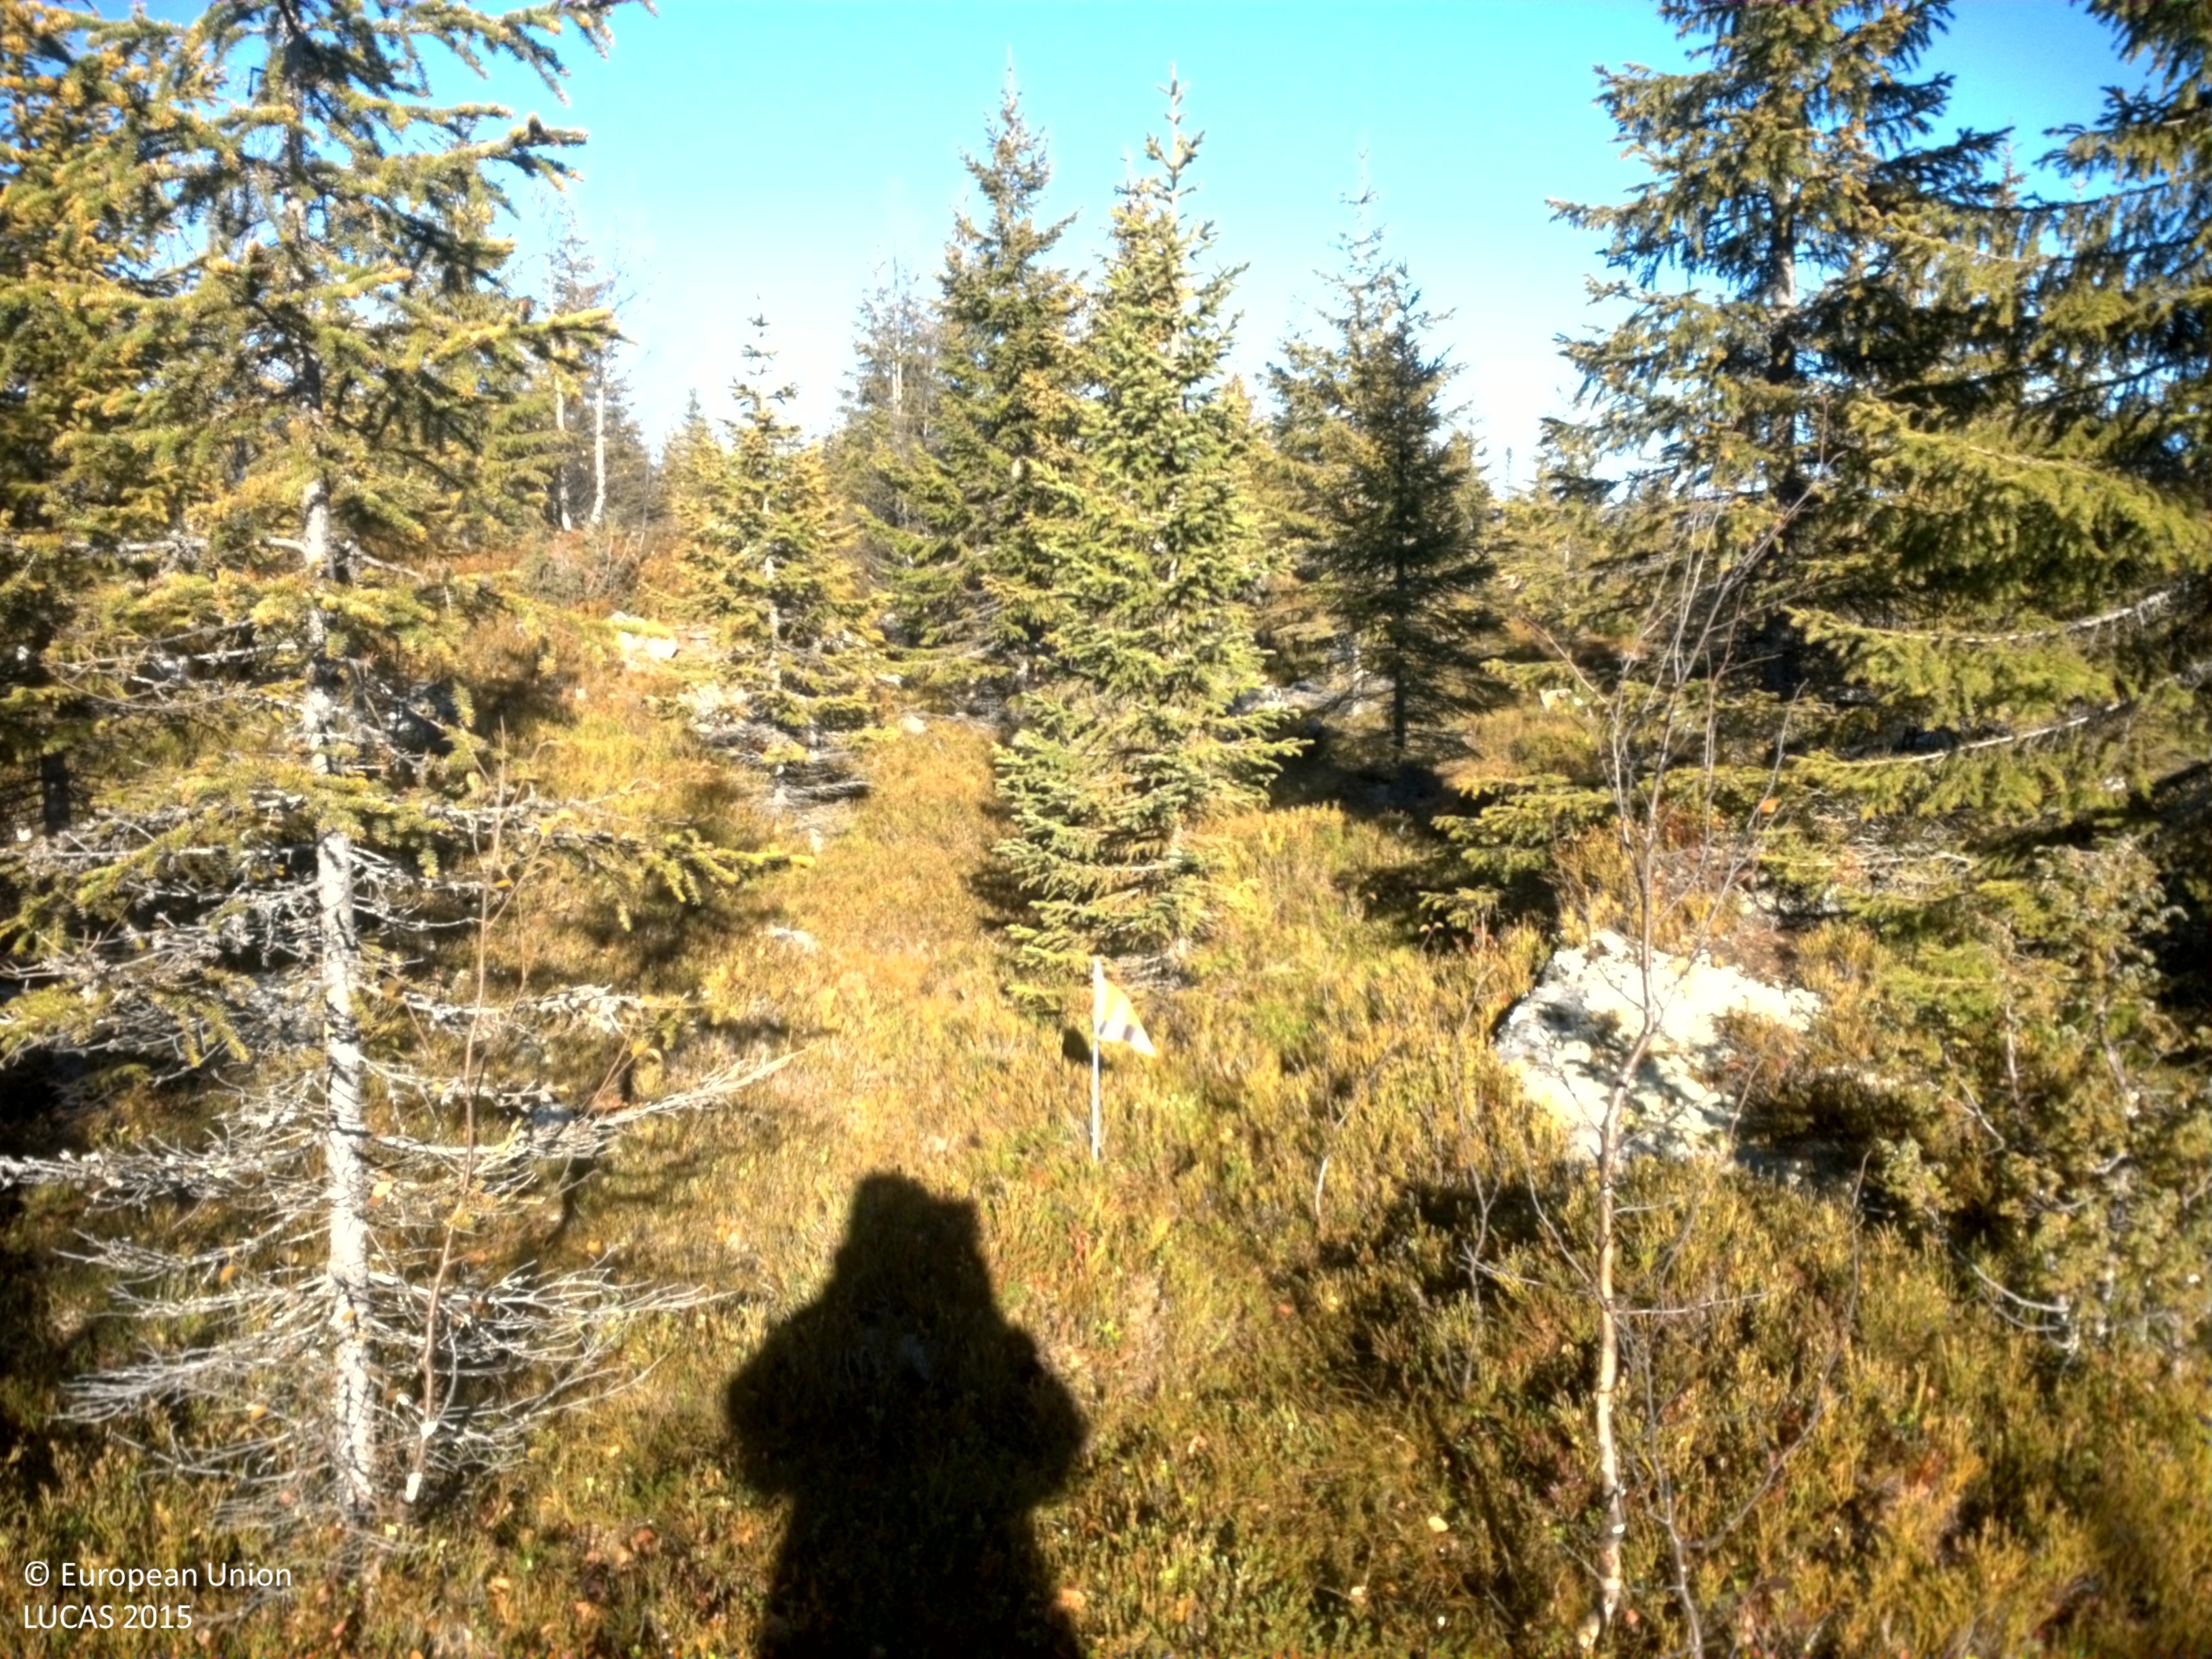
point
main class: Woodland
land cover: Spruce dominated coniferous woodland
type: boreal forest
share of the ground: 10 - 25 %
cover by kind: shrubs 65 %, coniferous forest trees 15 %, herbaceous plants 10 %, lichens and mosses 10 %
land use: Forestry
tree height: < 5 m
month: October
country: SE
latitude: 64.8645
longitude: 16.9068
